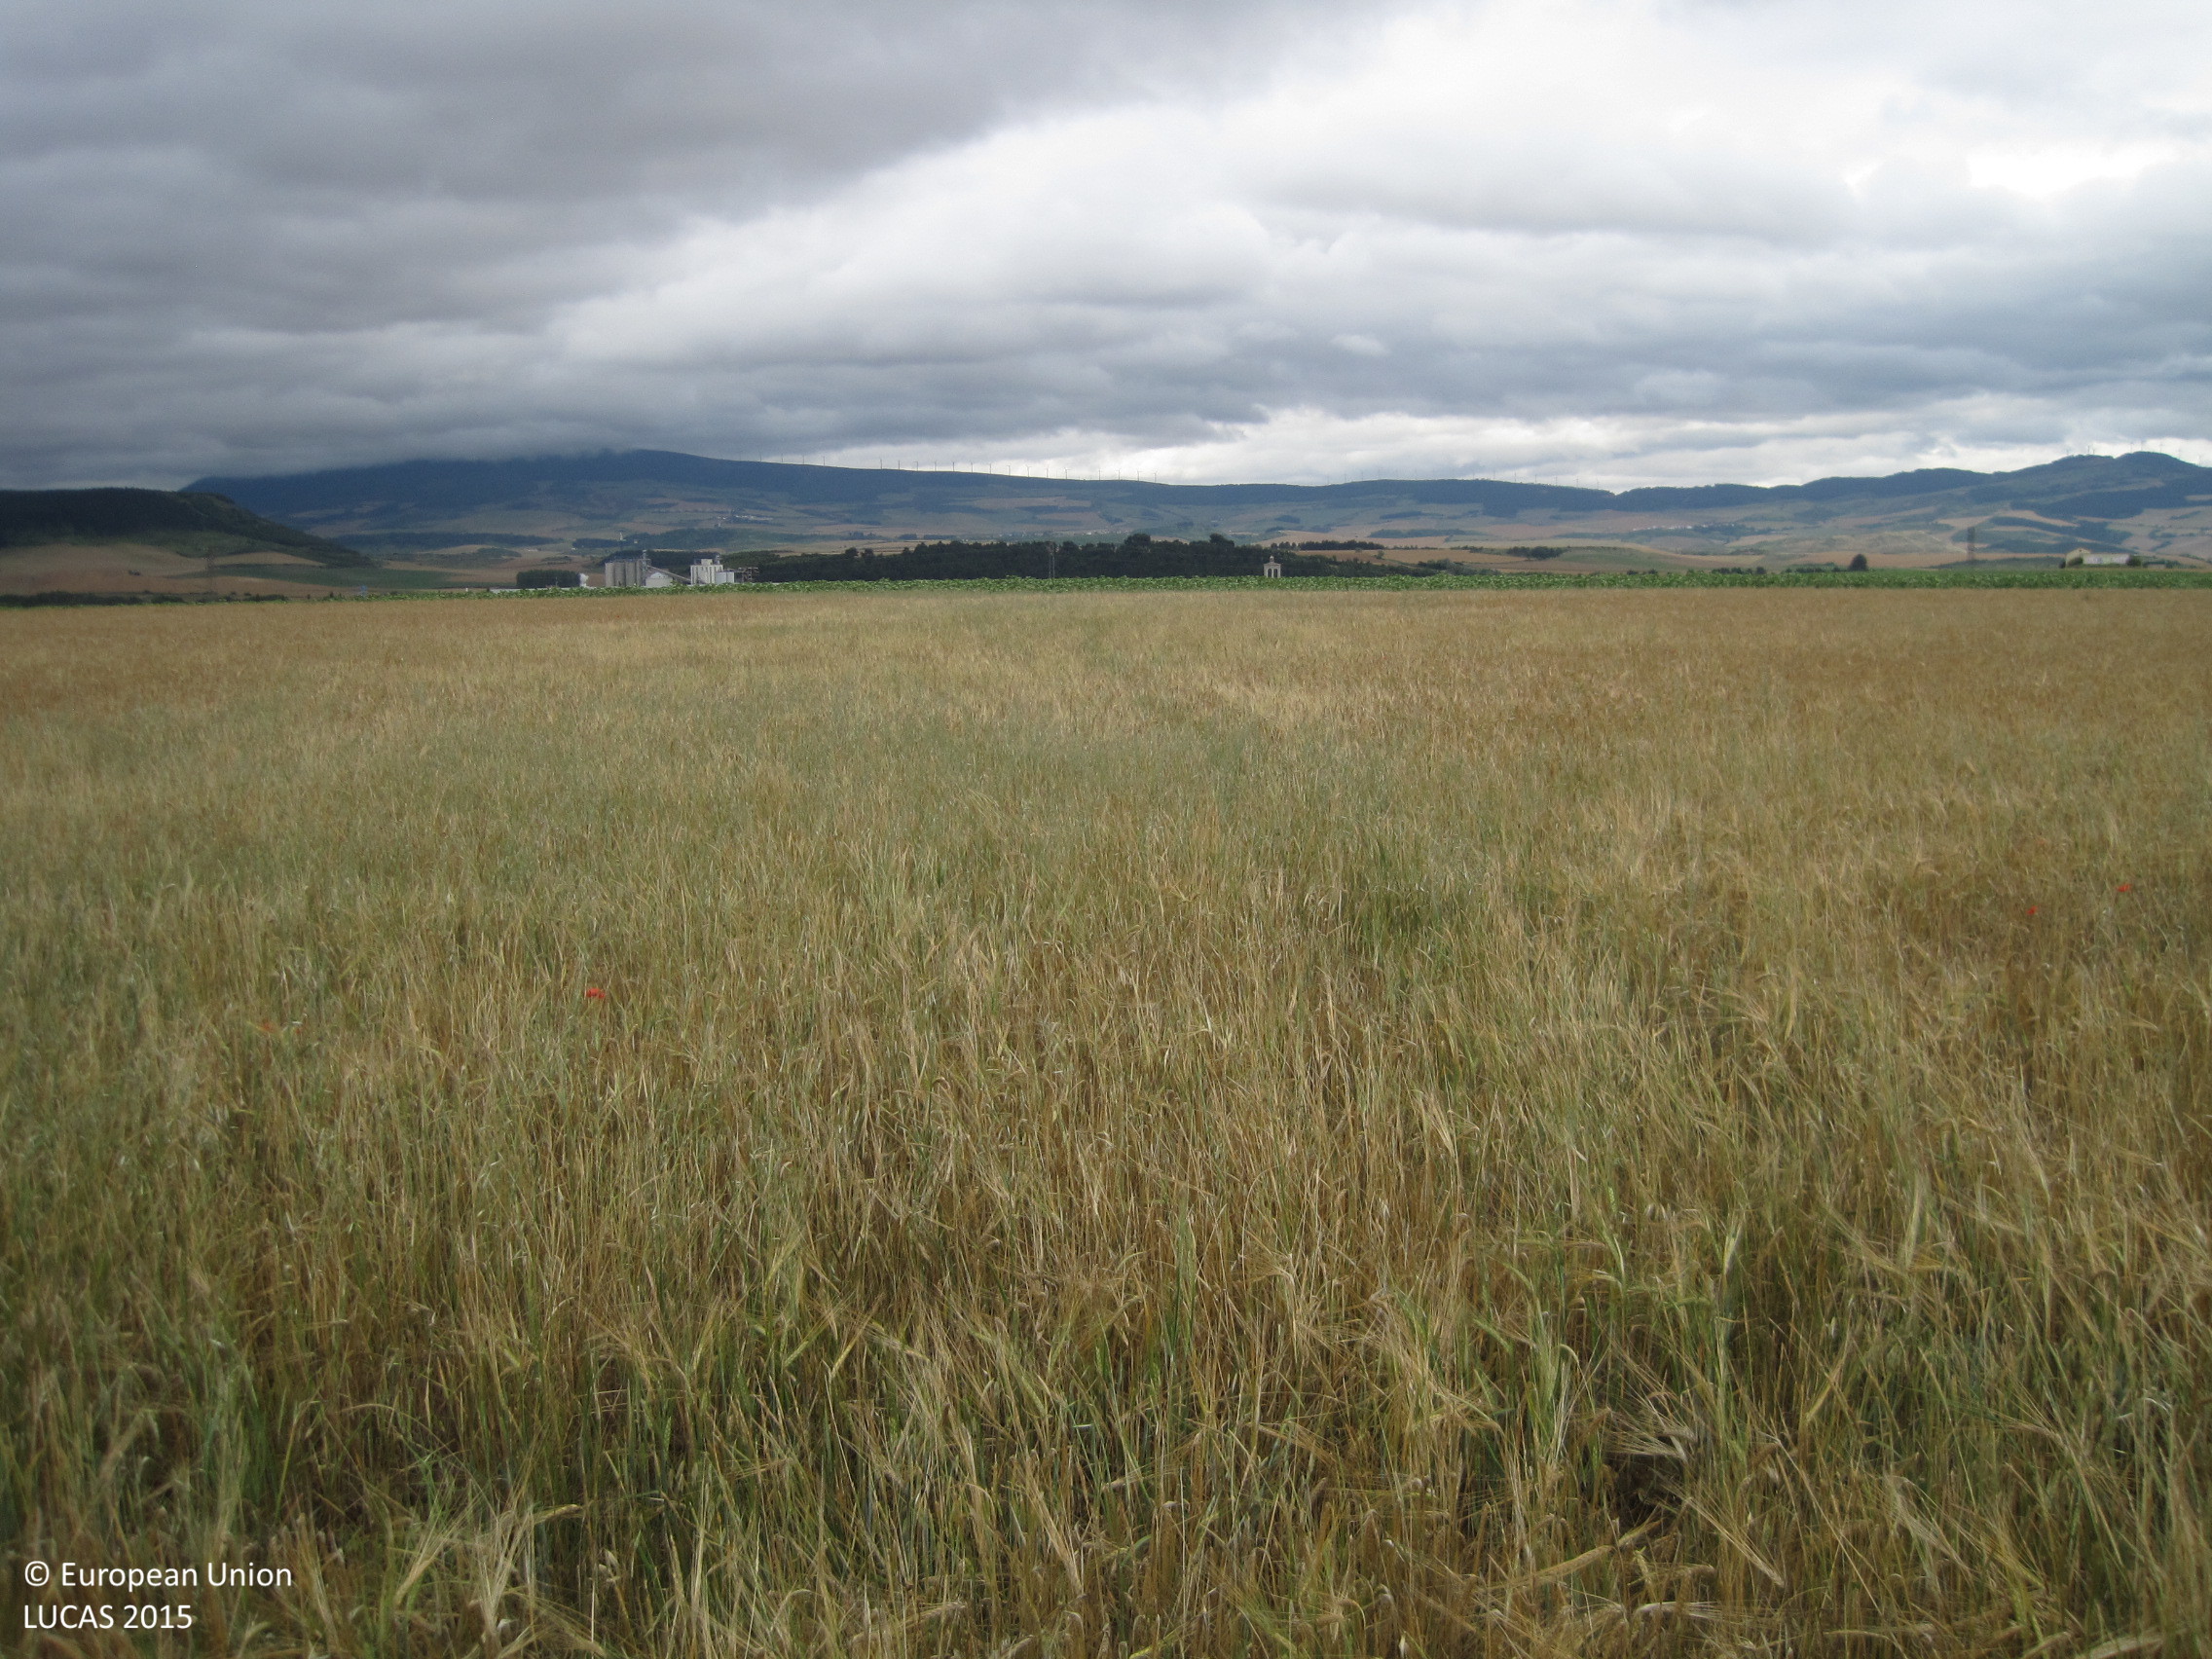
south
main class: Cropland
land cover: Mixed cereals for fodder
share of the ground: > 75 %
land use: Agriculture (excluding fallow land and kitchen gardens)
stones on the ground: < 10 %
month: June
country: ES
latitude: 42.8247
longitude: -1.7463
